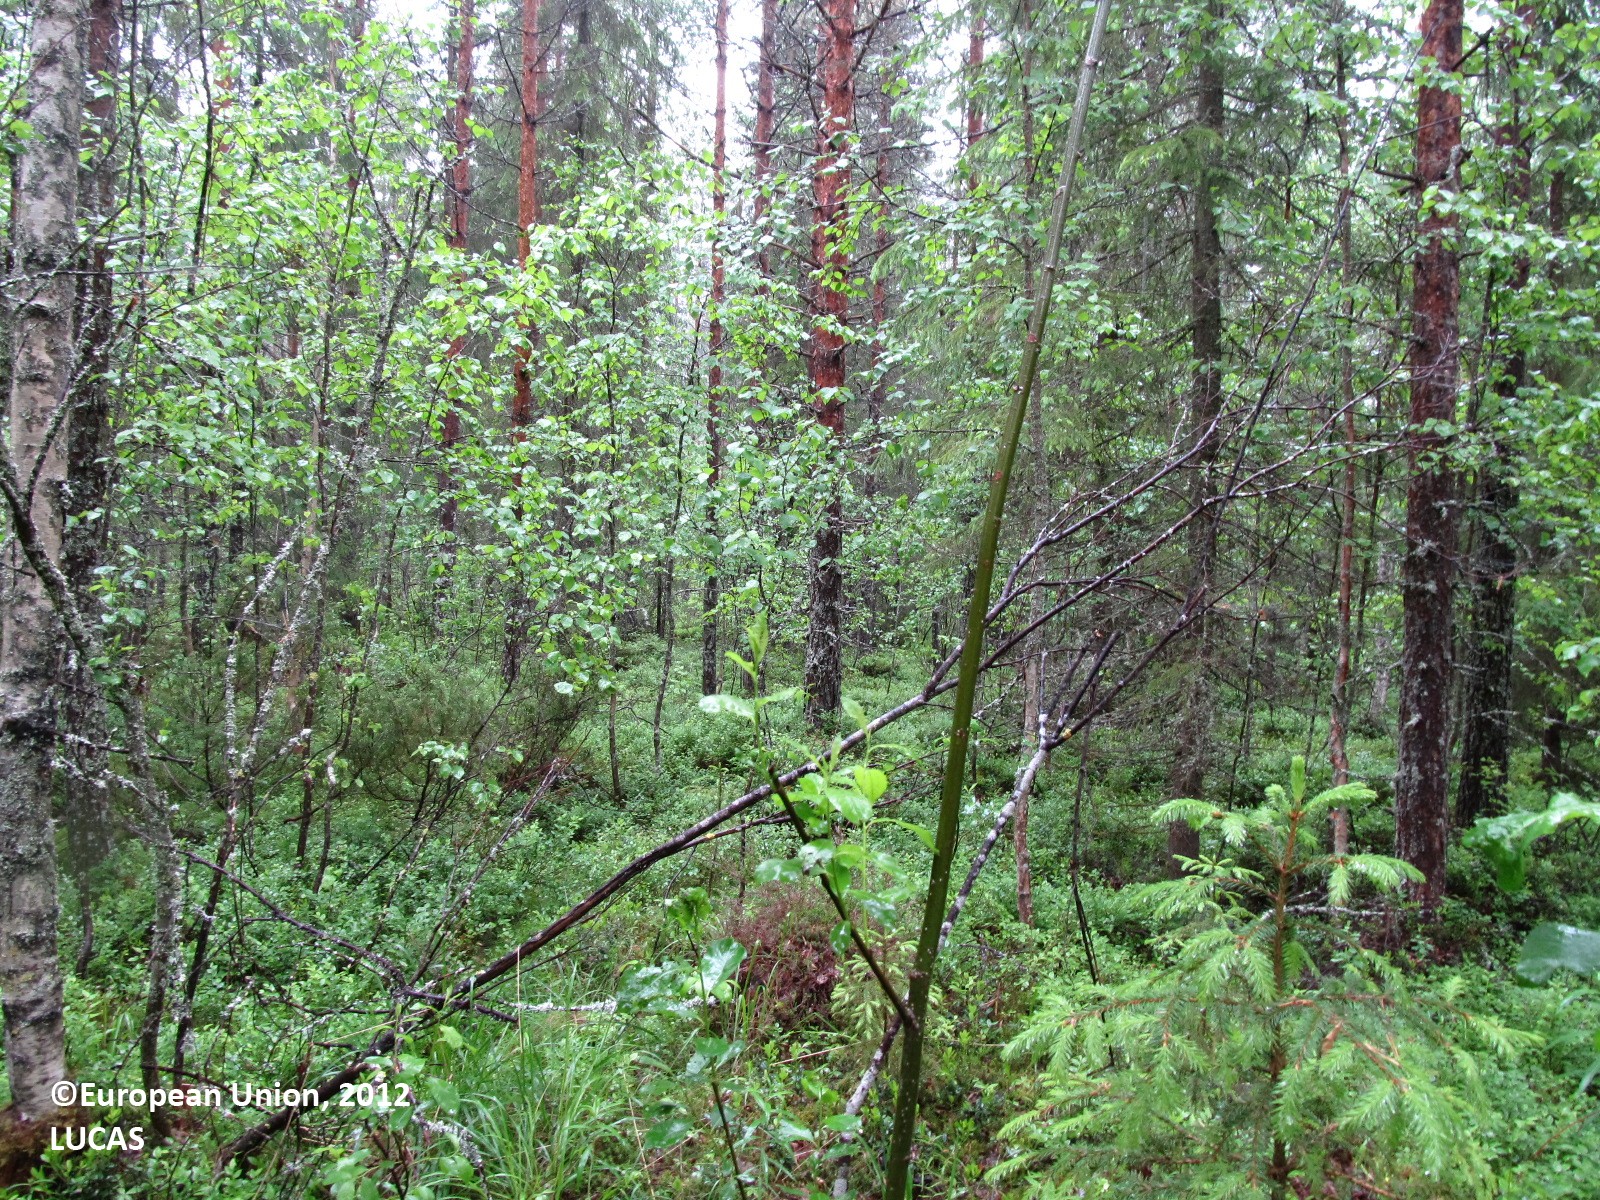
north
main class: Woodland
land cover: Pine dominated mixed woodland
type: boreal forest
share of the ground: 50 - 75 %
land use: Forestry
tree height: > 5 m
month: June
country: FI
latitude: 63.0722
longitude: 29.0783
